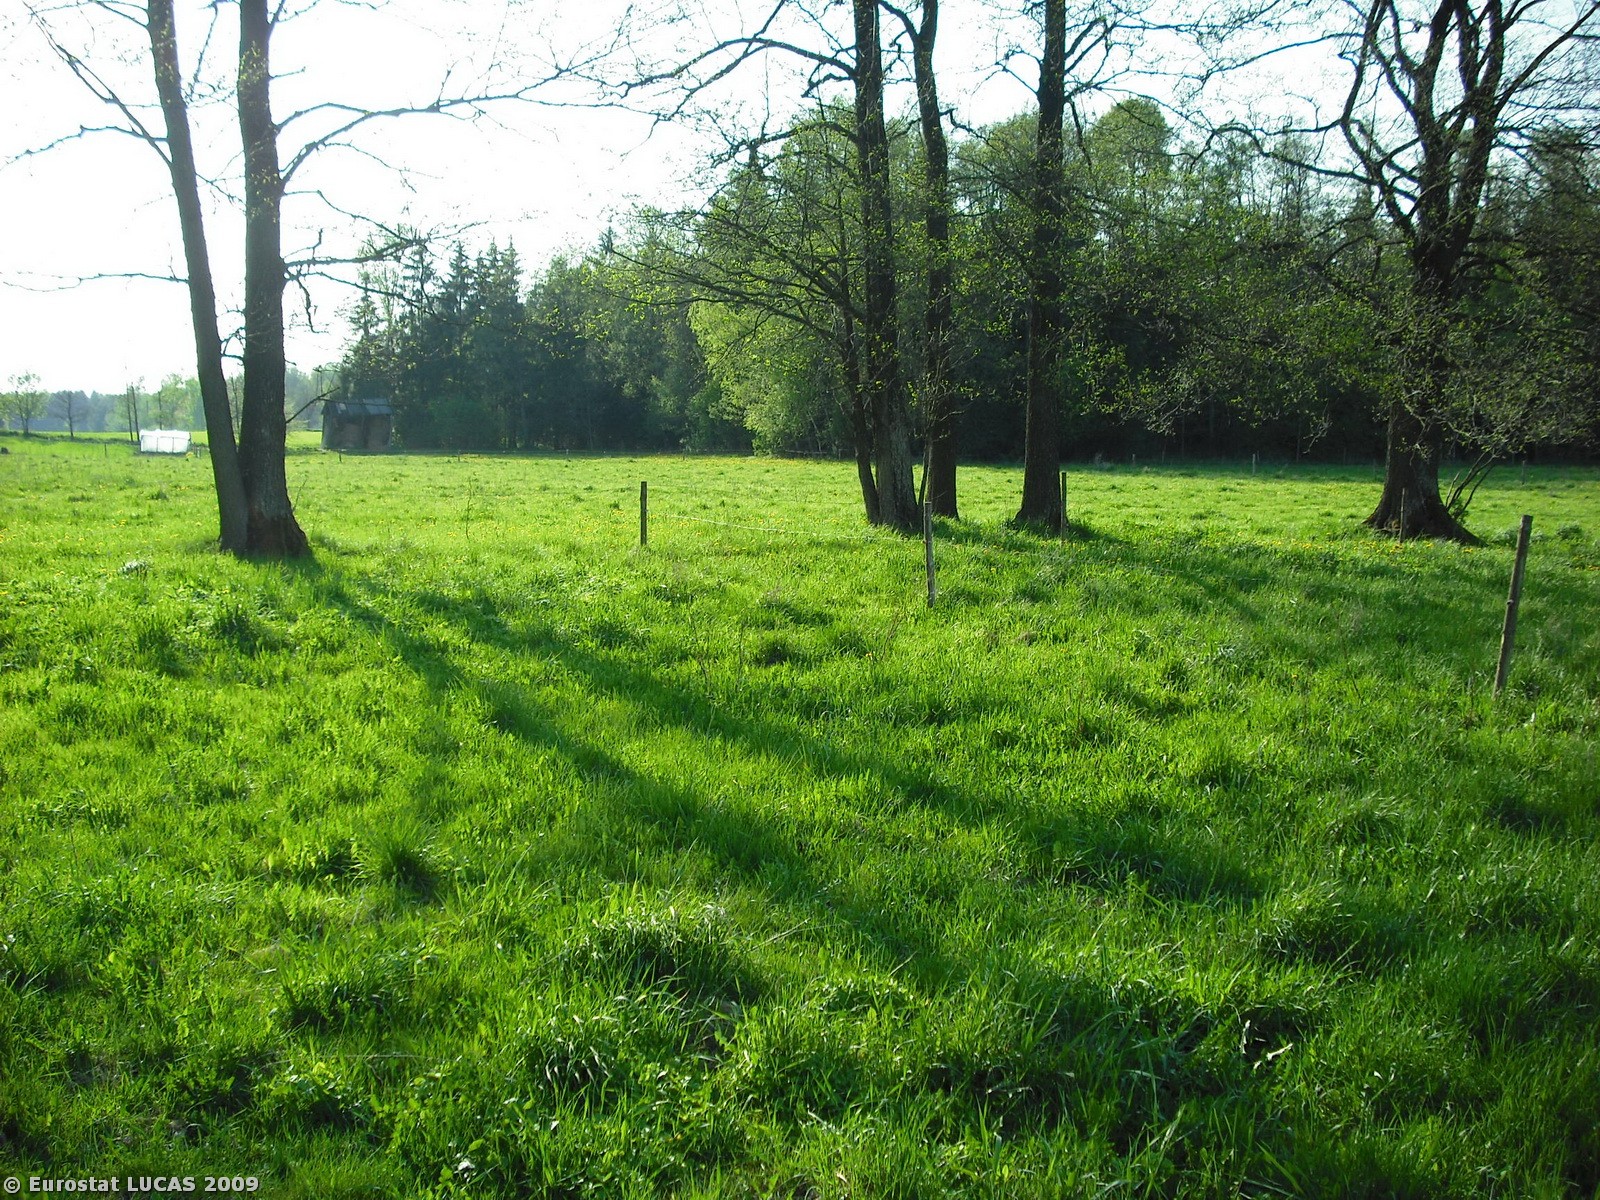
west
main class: Grassland
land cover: Grassland without tree/shrub cover
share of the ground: 50 - 75 %
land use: Agriculture (excluding fallow land and kitchen gardens)
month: August
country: PL
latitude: 53.0335
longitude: 23.5811
